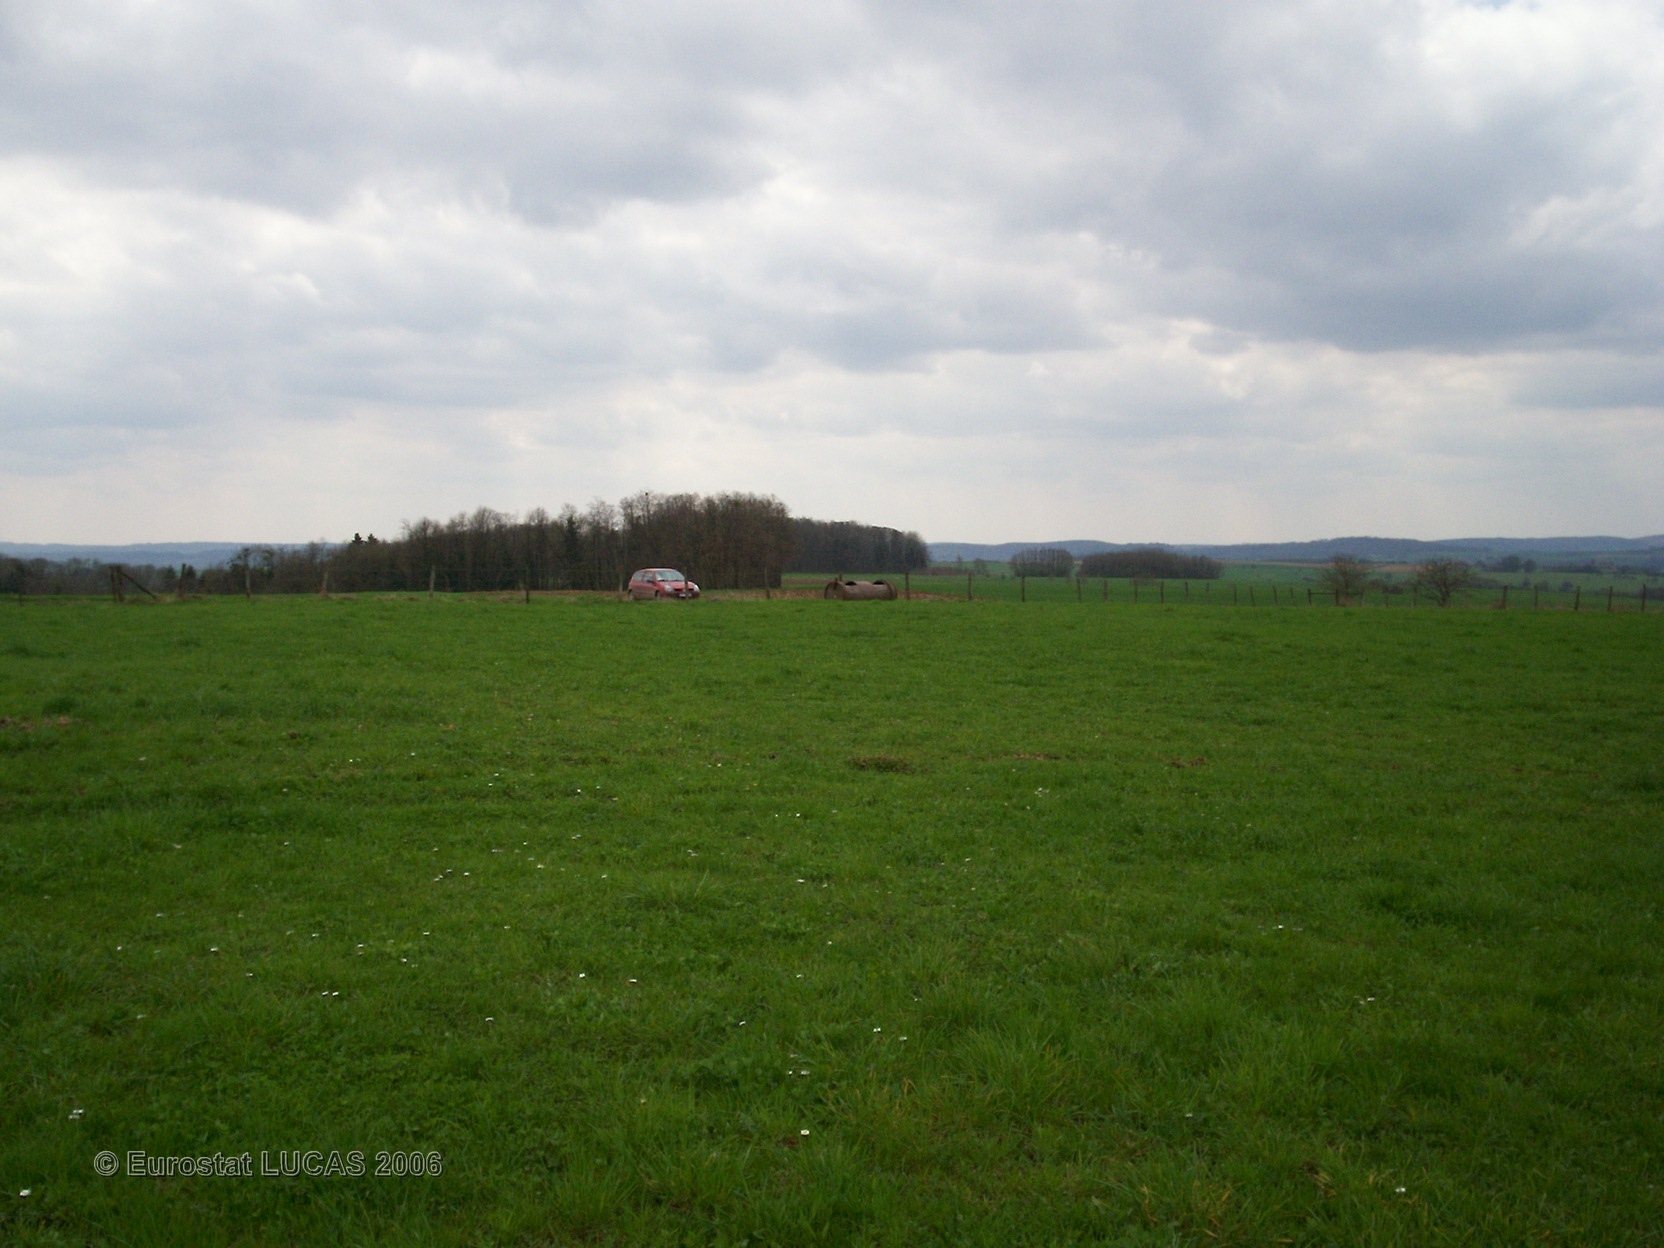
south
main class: Grassland
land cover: Grassland without tree/shrub cover
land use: Agriculture (excluding fallow land and kitchen gardens)
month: April
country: FR
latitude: 47.9697
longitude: 5.9688
